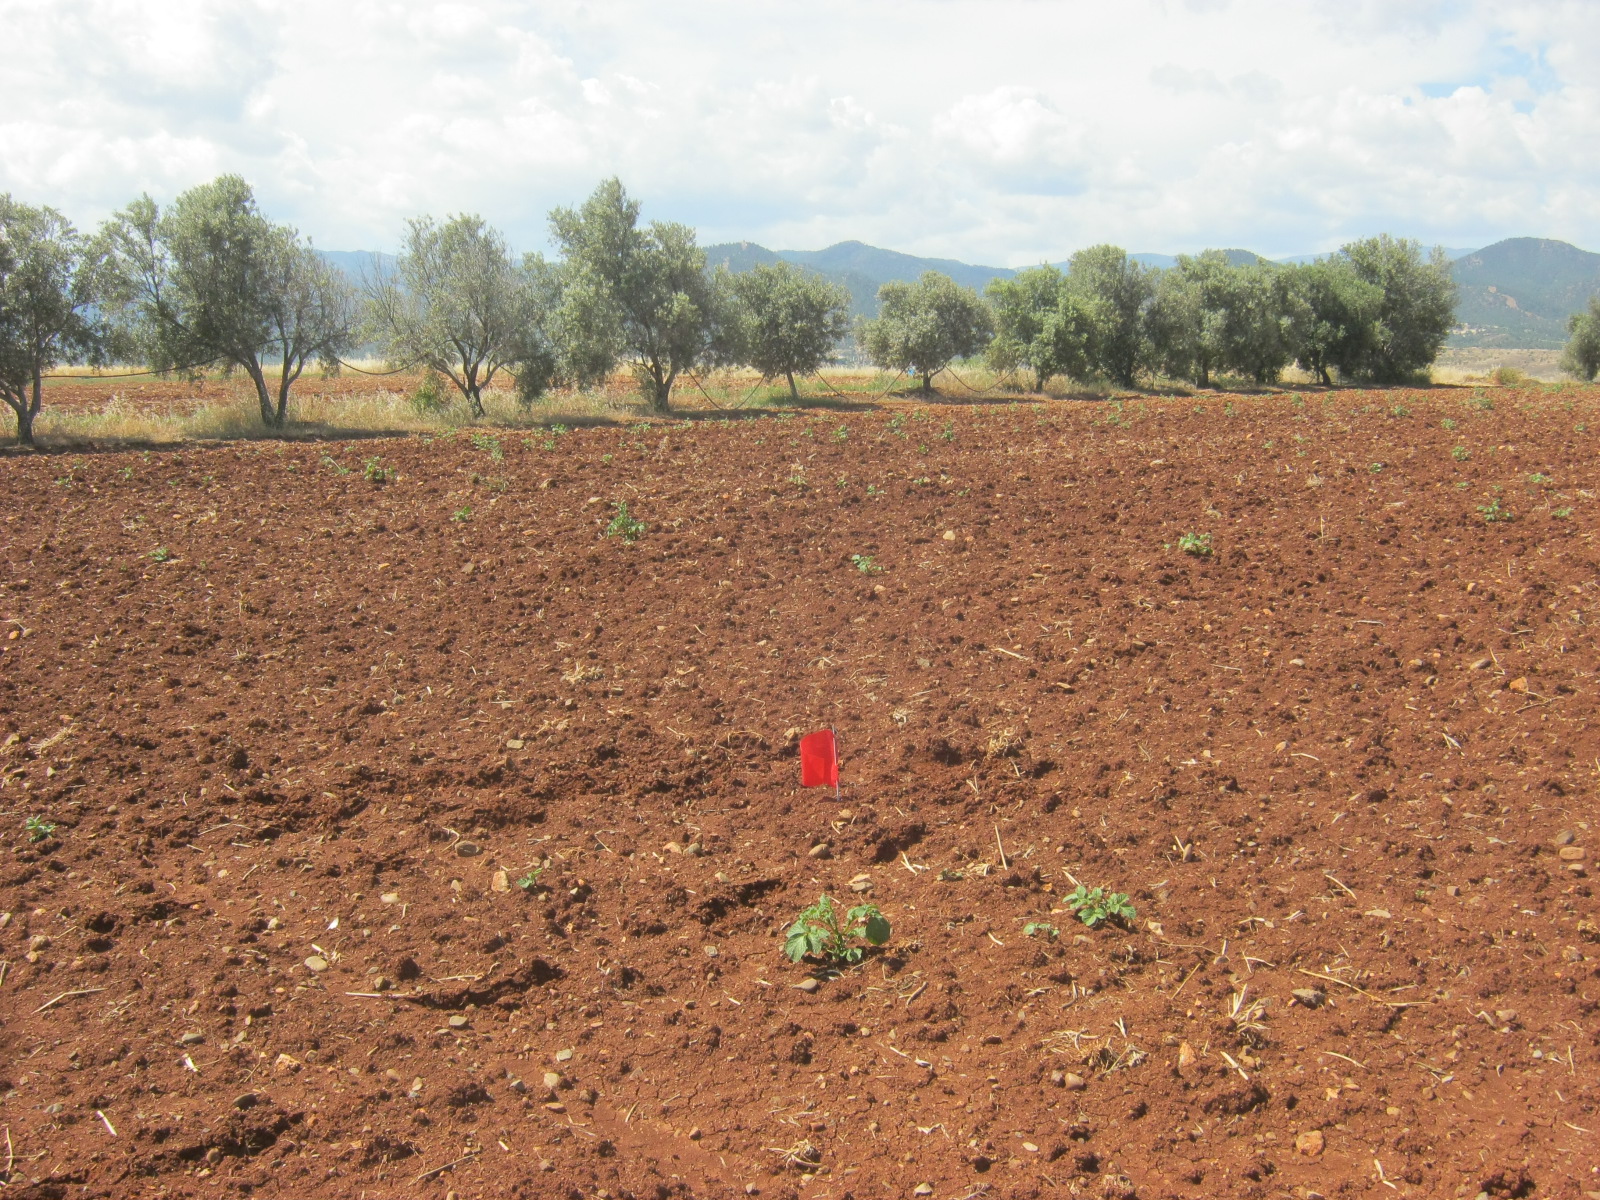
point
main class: Cropland
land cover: Potatoes
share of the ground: < 10 %
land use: Agriculture (excluding fallow land and kitchen gardens)
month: May
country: CY
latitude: 35.0930
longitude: 33.0040
